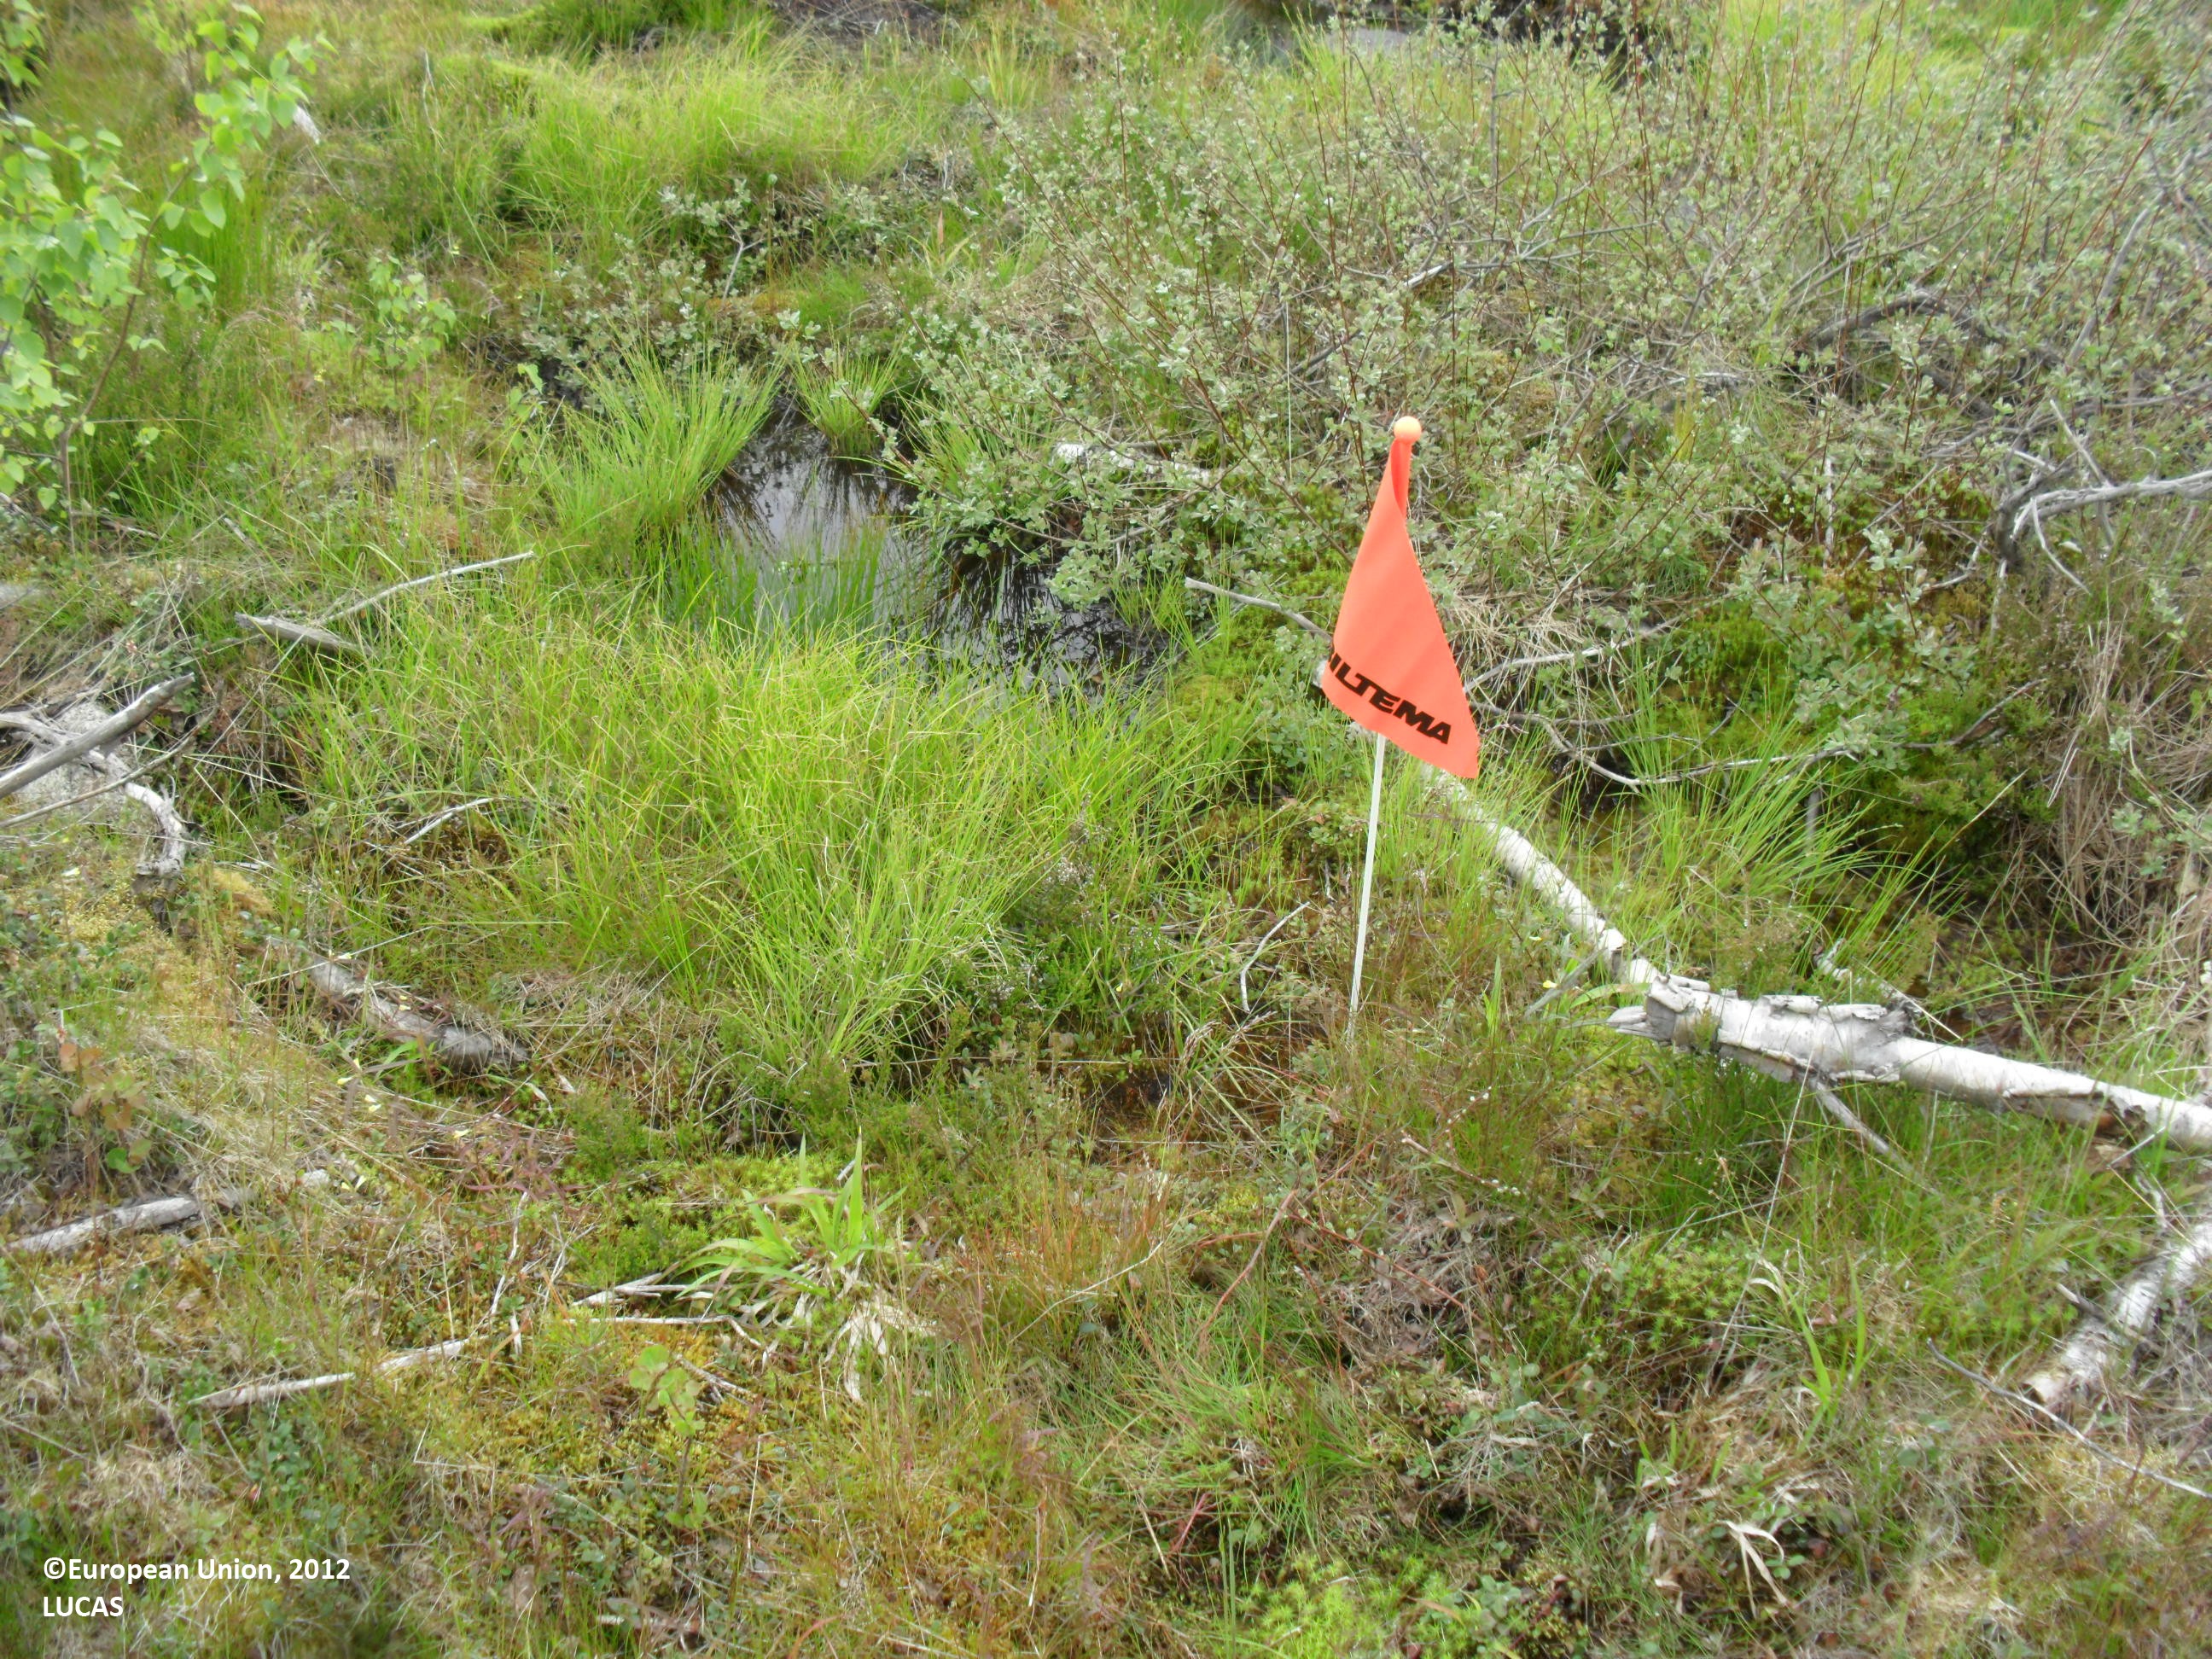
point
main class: Grassland
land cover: Grassland with sparse tree/shrub cover
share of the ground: > 75 %
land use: Forestry
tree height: < 5 m
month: June
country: FI
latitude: 63.2005
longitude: 22.9988
